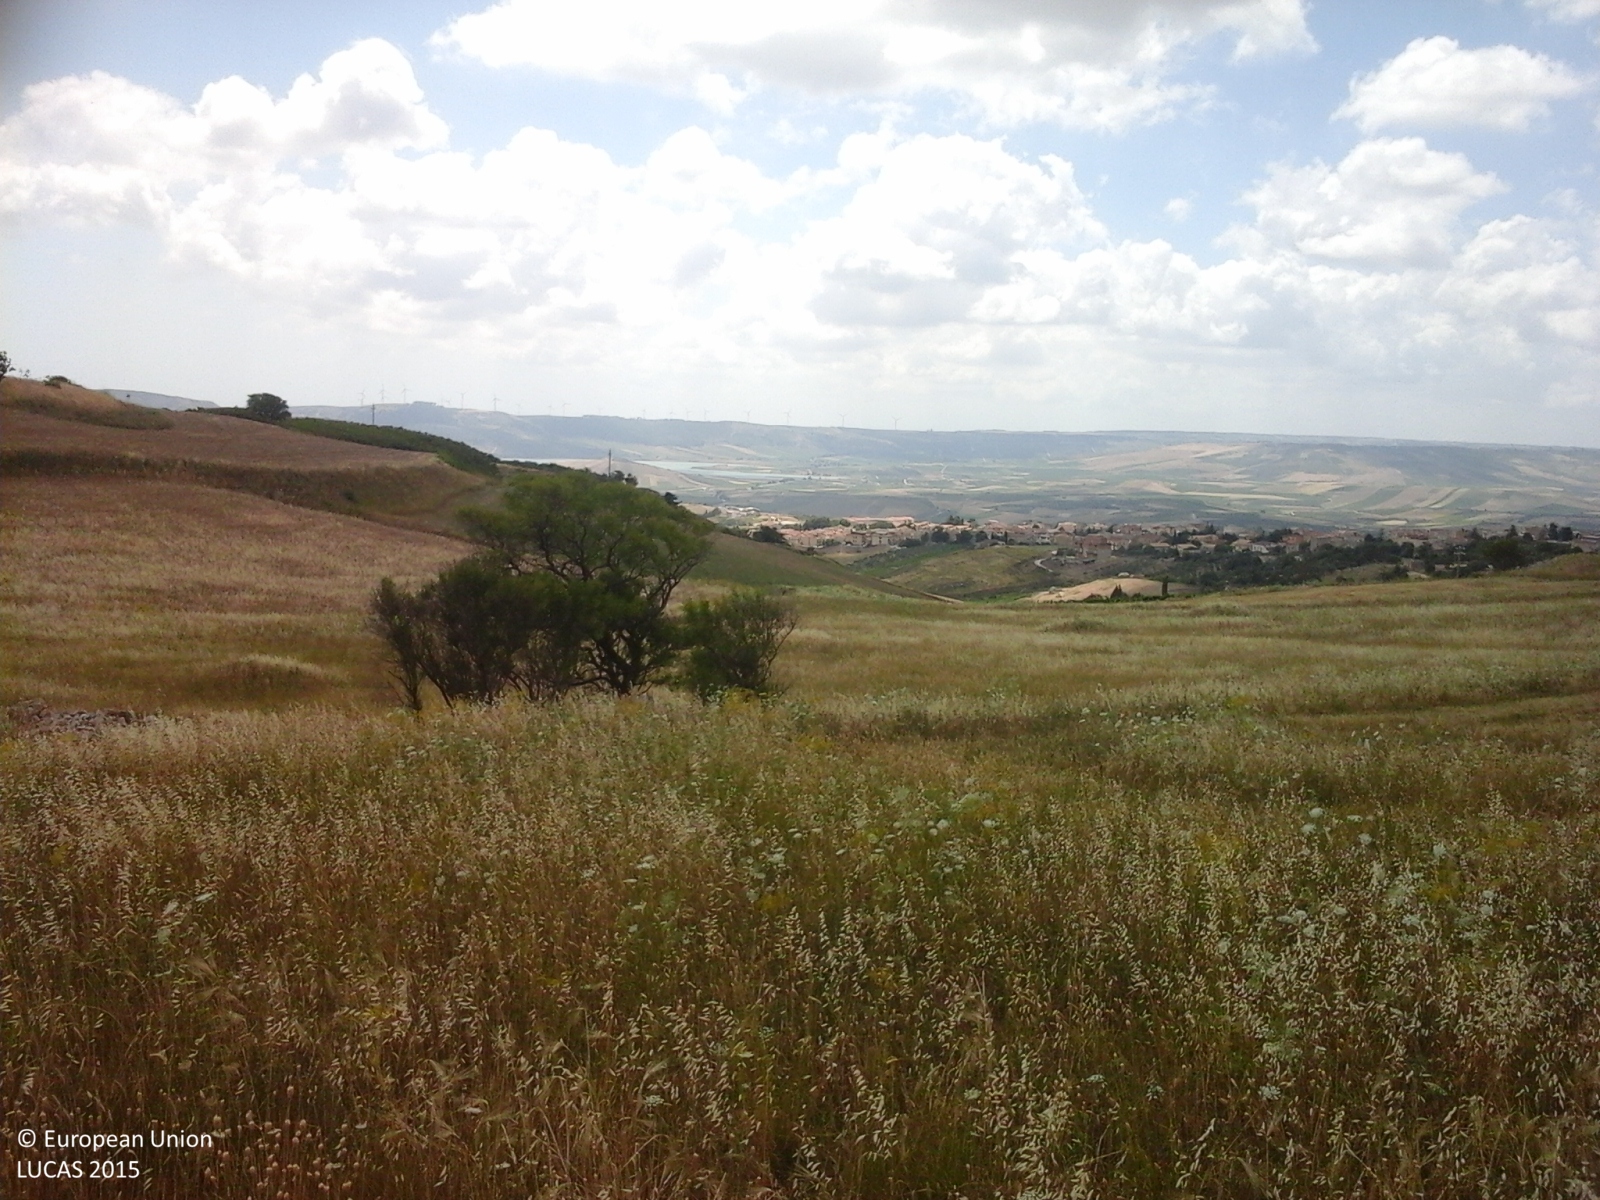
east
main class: Cropland
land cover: Durum wheat
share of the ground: > 75 %
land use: Agriculture (excluding fallow land and kitchen gardens)
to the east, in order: Durum wheat; Grassland without tree/shrub cover
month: June
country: IT
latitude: 37.6594
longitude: 13.1391
